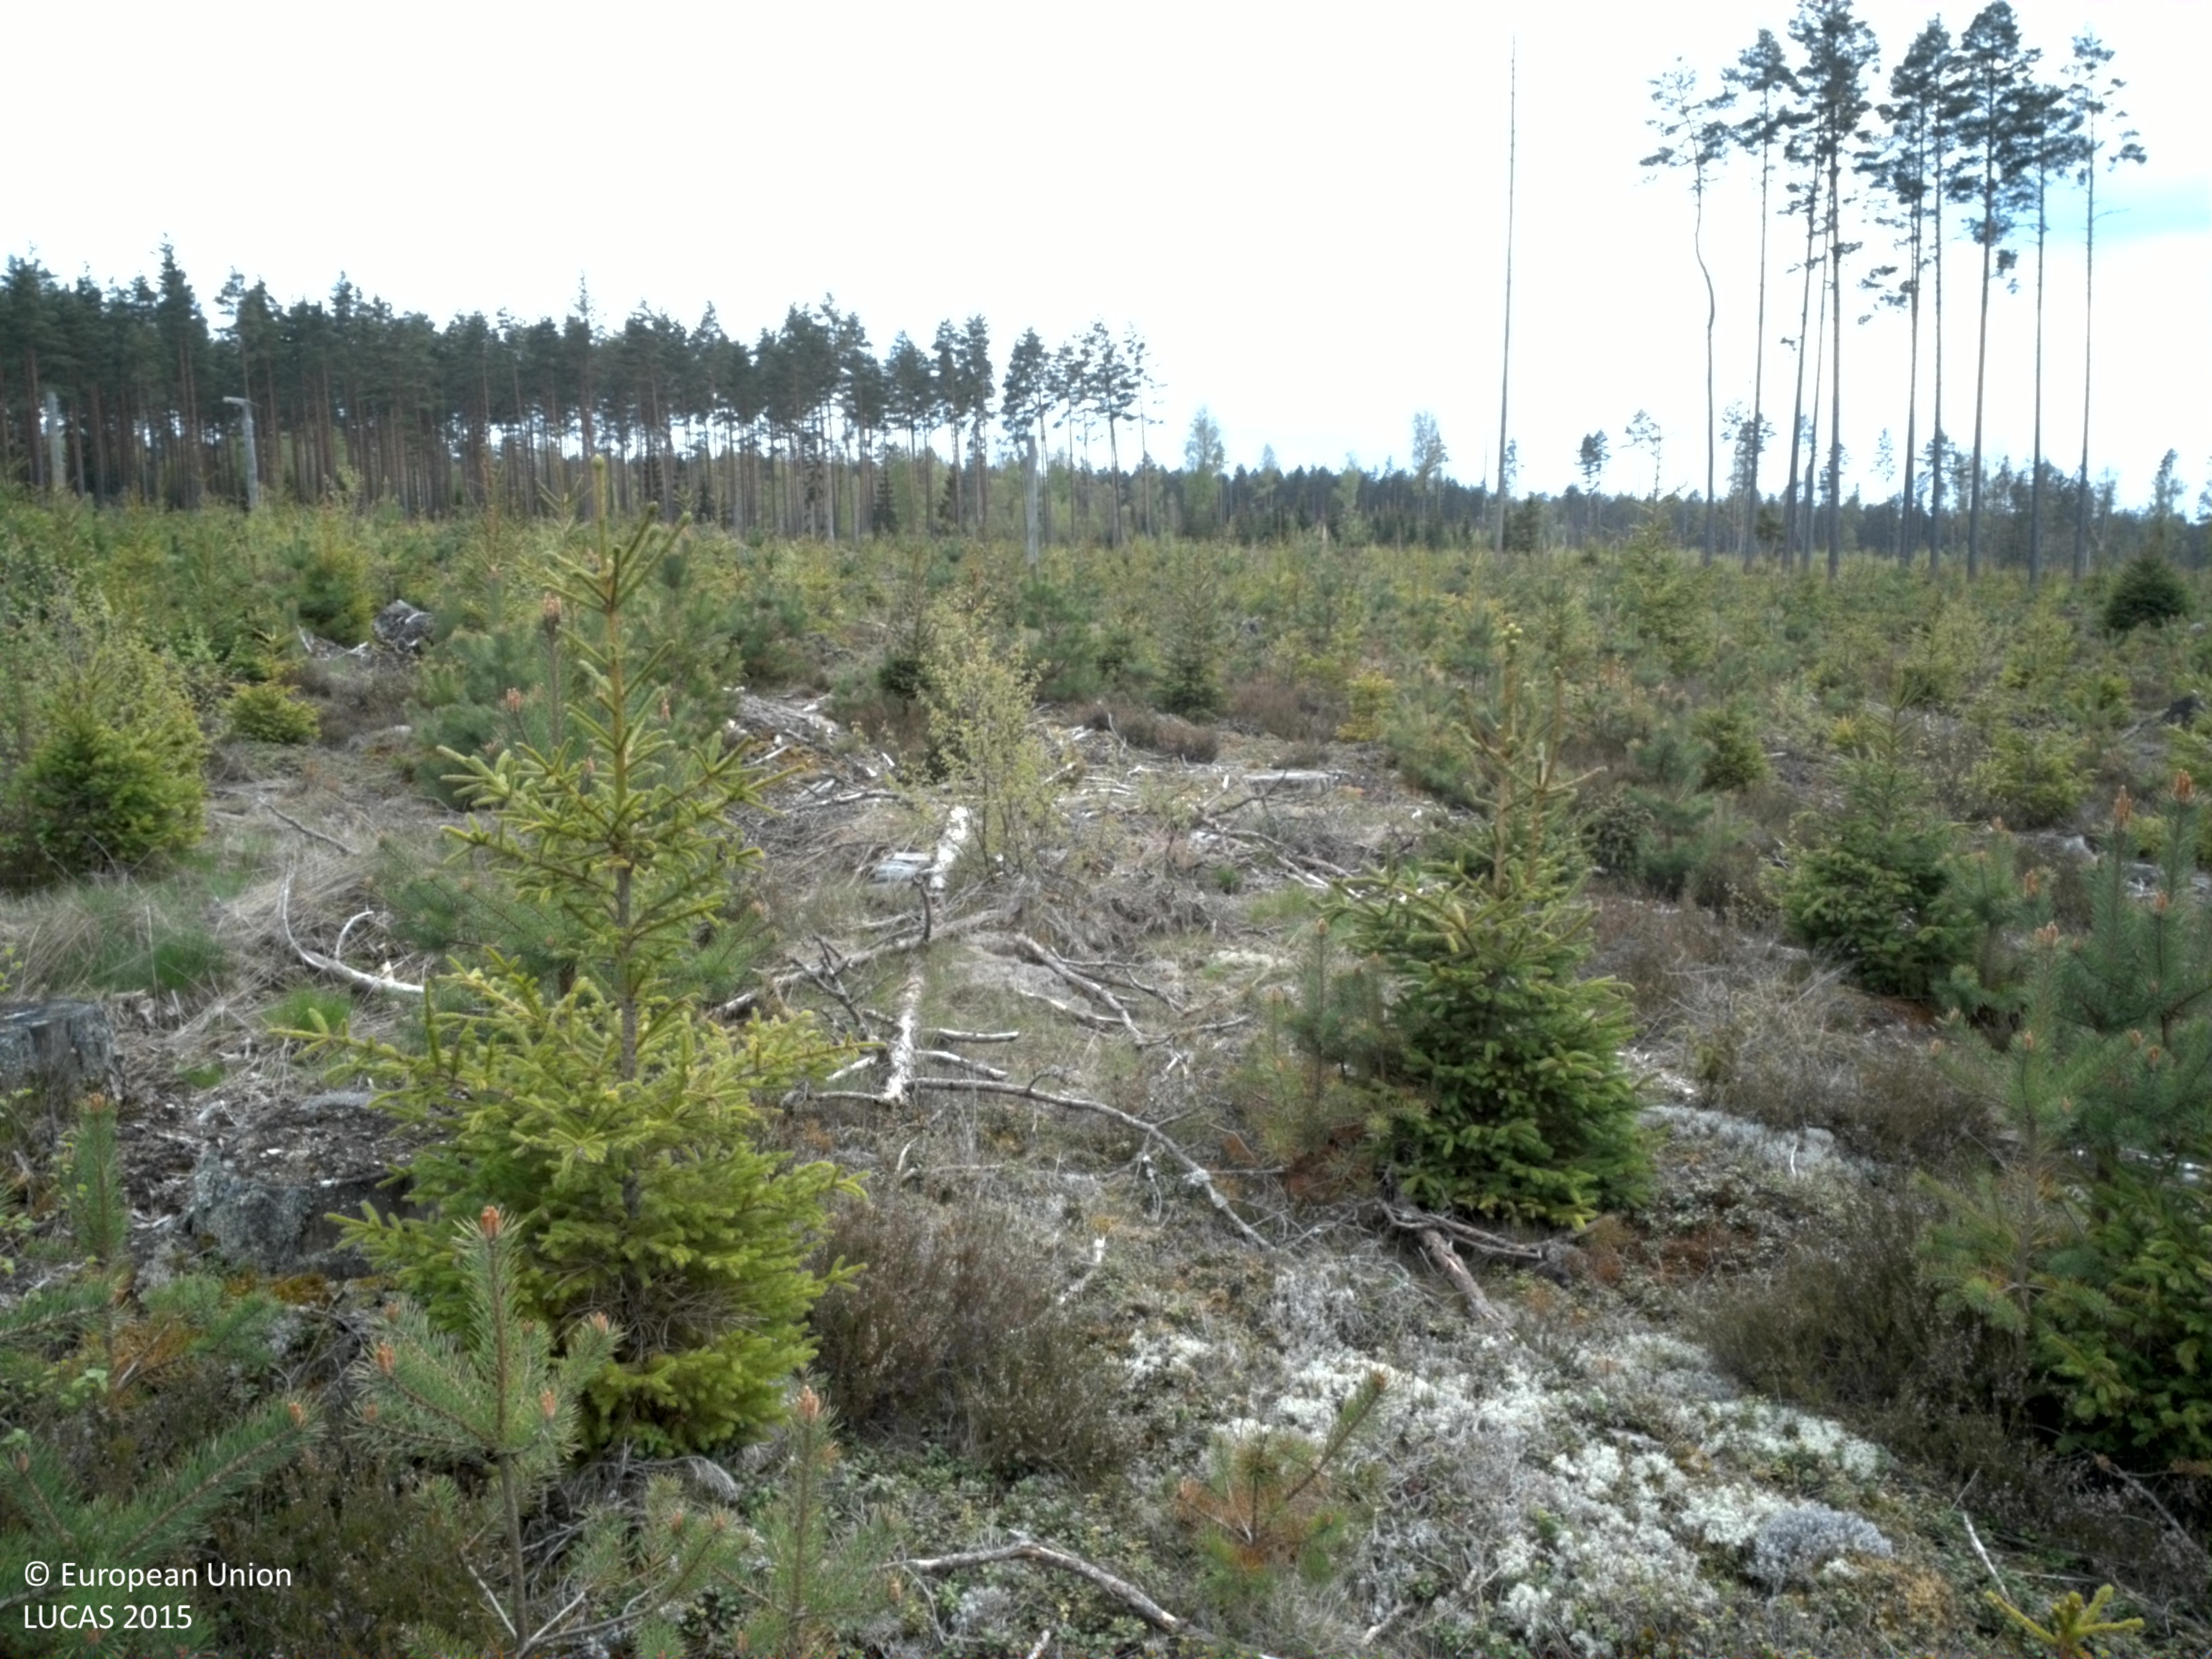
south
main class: Woodland
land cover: Other coniferous woodland
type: boreal forest
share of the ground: > 75 %
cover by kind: coniferous forest trees 90 %, shrubs 5 %, lichens and mosses 5 %
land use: Forestry
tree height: < 5 m
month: May
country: SE
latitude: 56.7764
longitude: 15.4150
